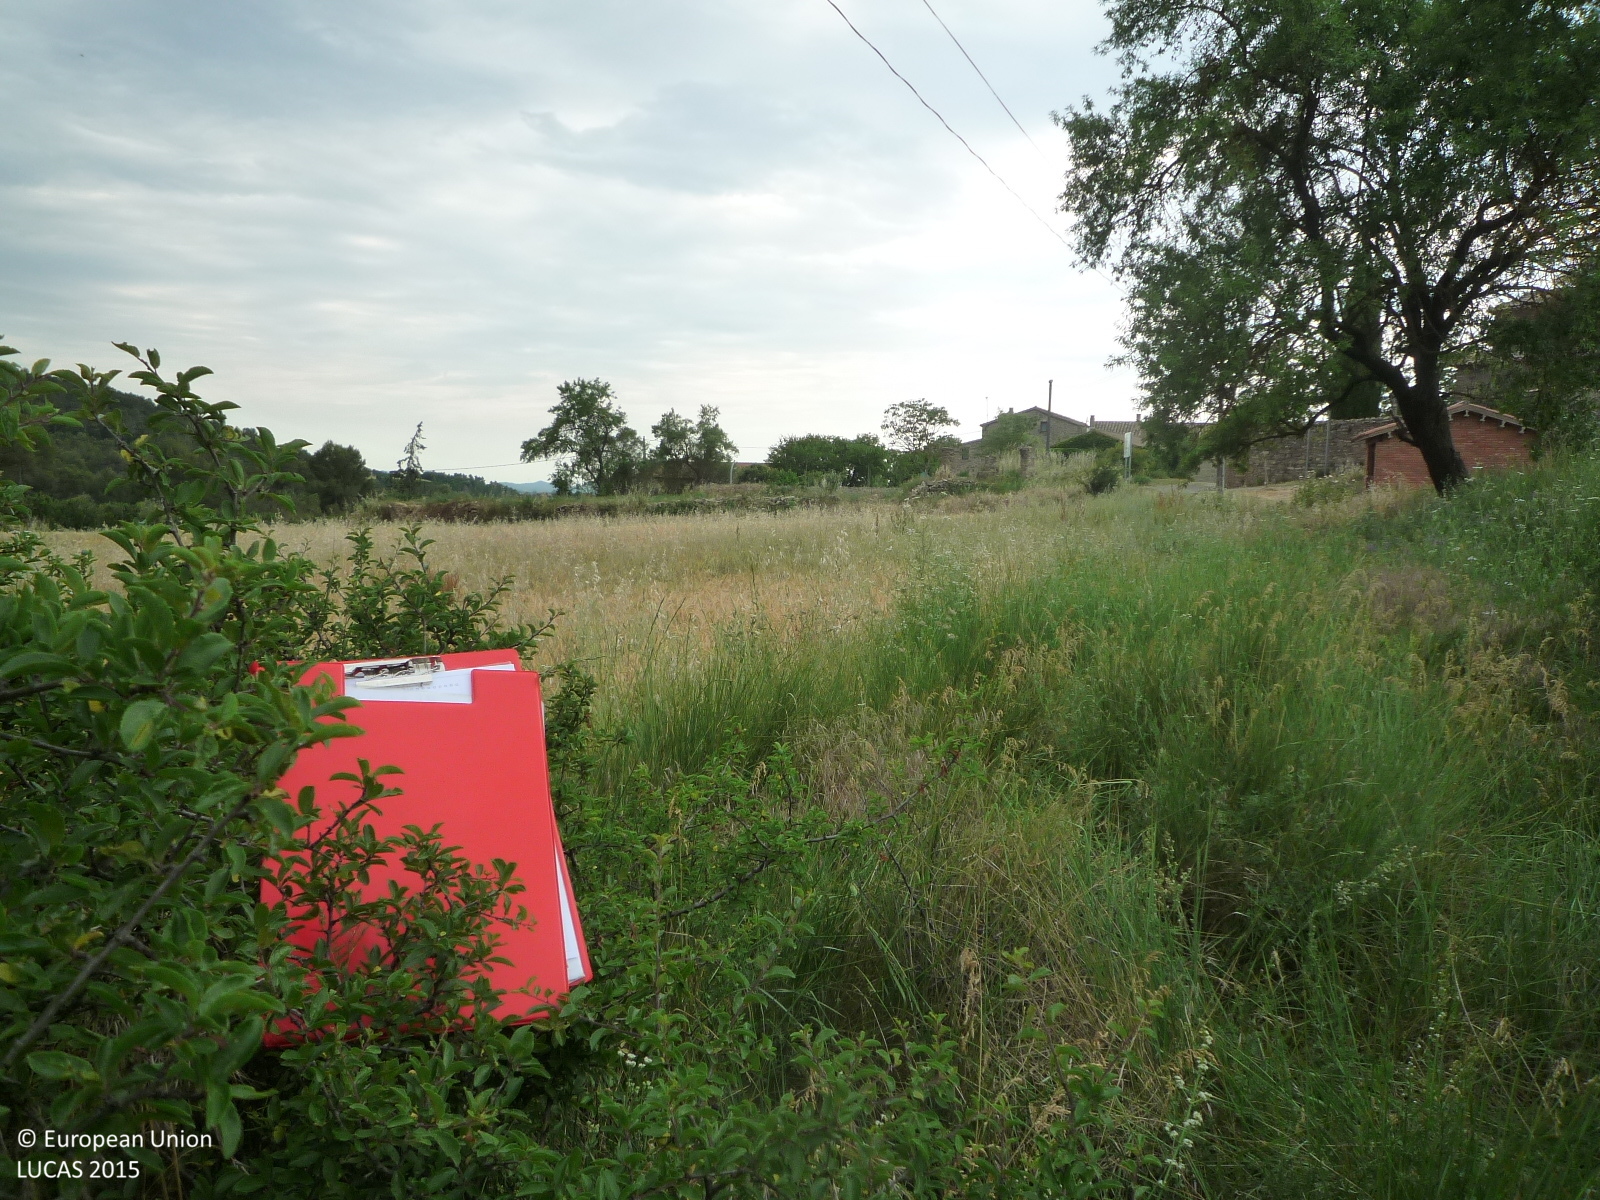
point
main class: Shrubland
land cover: Shrubland without tree cover
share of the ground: > 75 %
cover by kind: shrubs 70 %, herbaceous plants 30 %
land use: Semi-natural and natural areas not in use
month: June
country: ES
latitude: 41.8477
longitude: 2.0055
